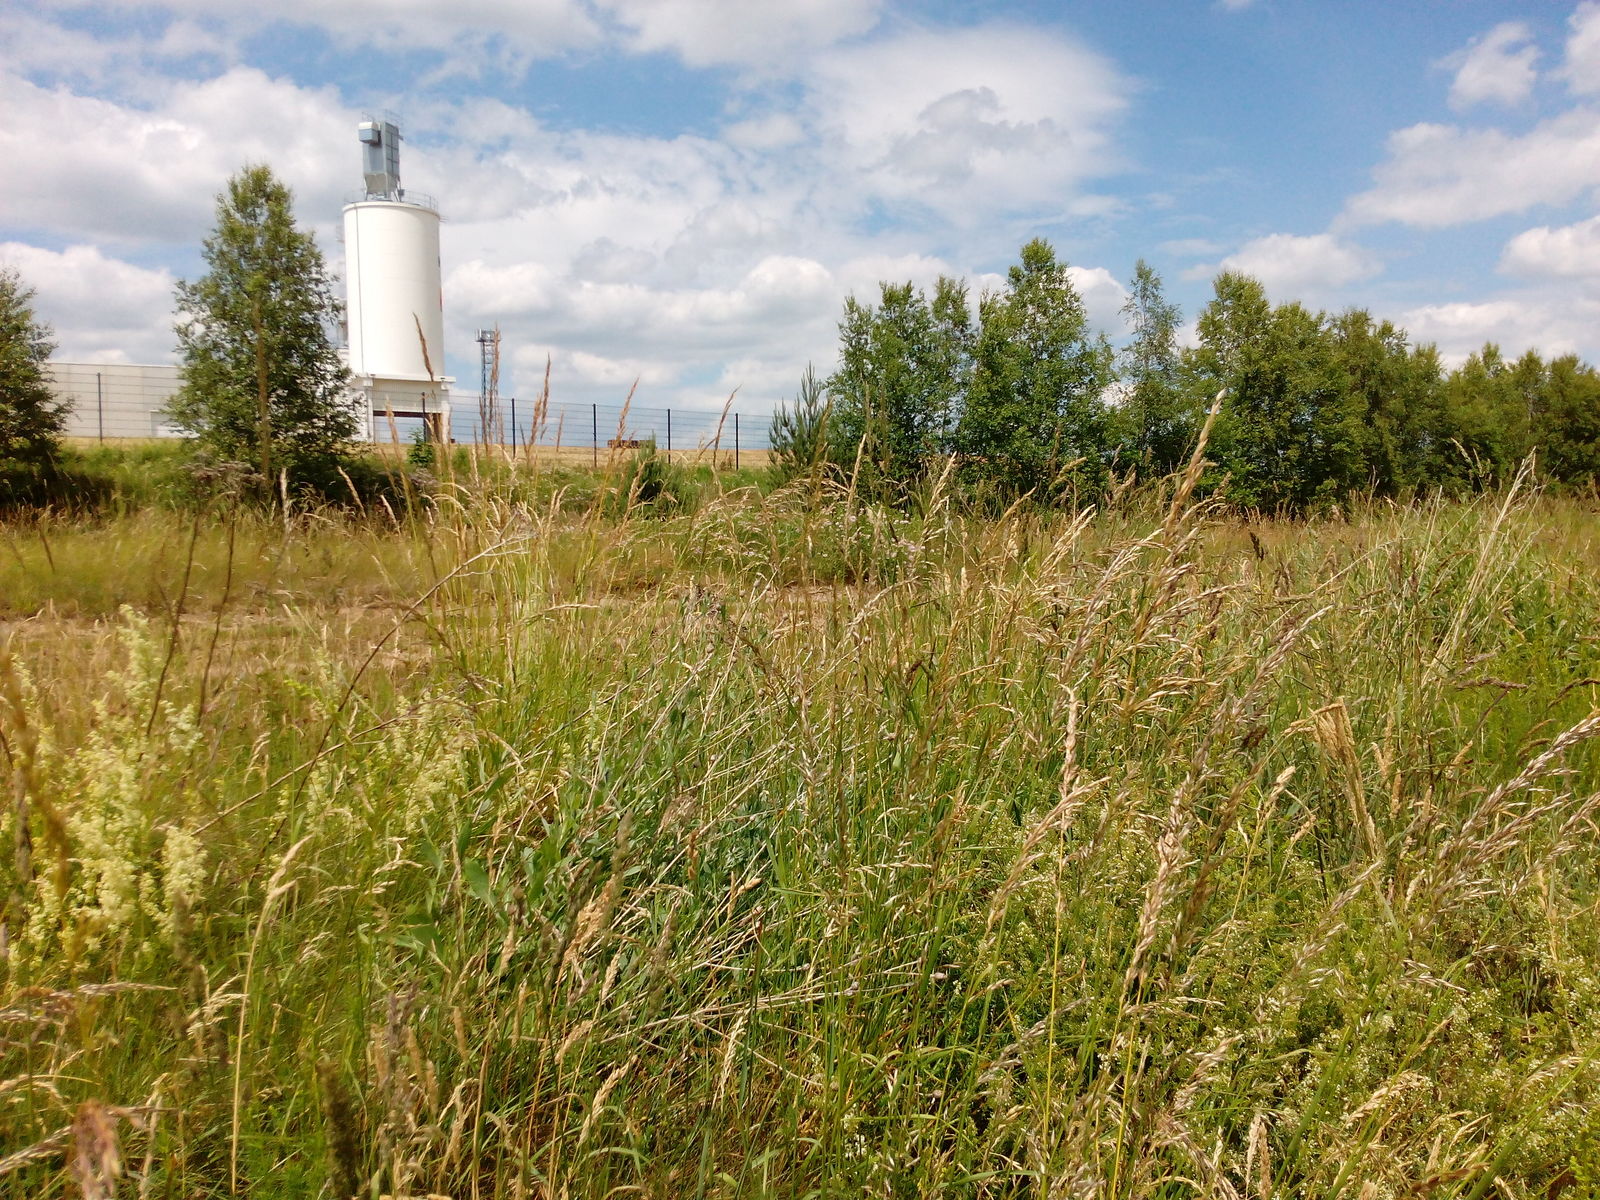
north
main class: Cropland
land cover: Triticale
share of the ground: > 75 %
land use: Agriculture (excluding fallow land and kitchen gardens)
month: June
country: DE
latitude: 50.7206
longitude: 10.8355
